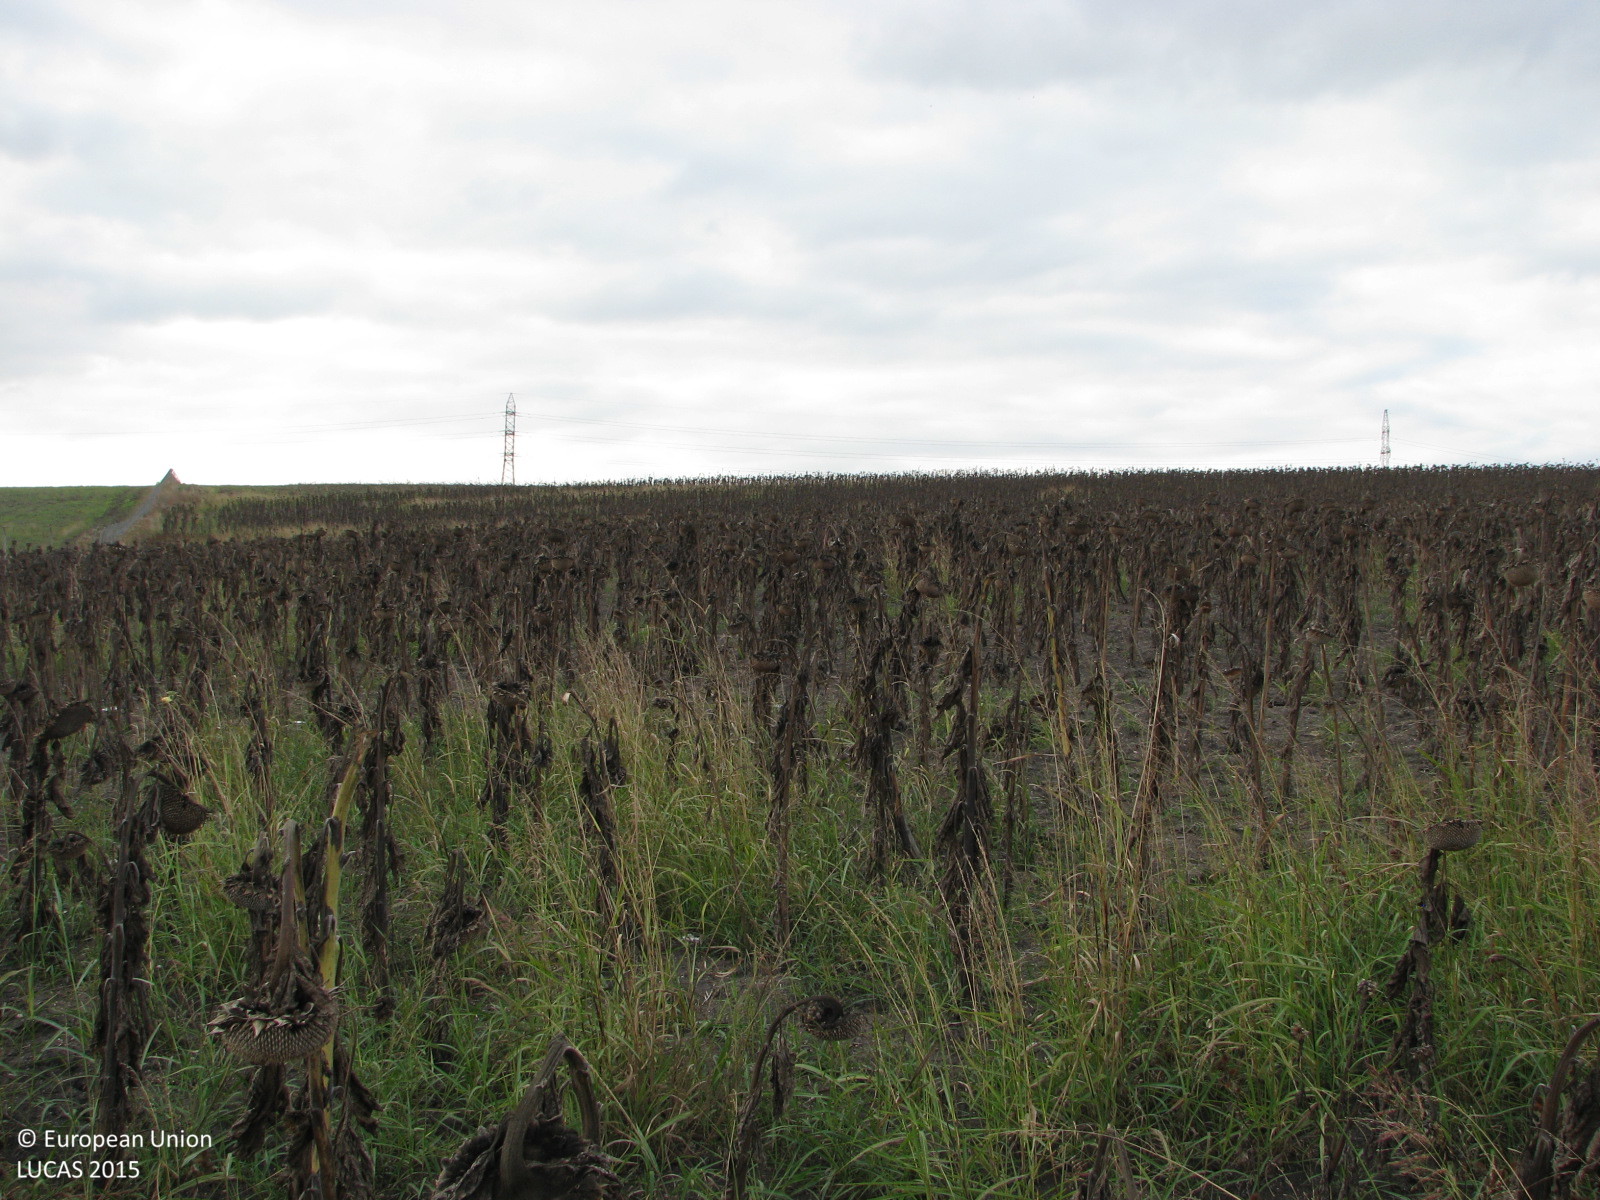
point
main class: Cropland
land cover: Sunflower
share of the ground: 50 - 75 %
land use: Agriculture (excluding fallow land and kitchen gardens)
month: October
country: BG
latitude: 42.2678
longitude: 26.1451
